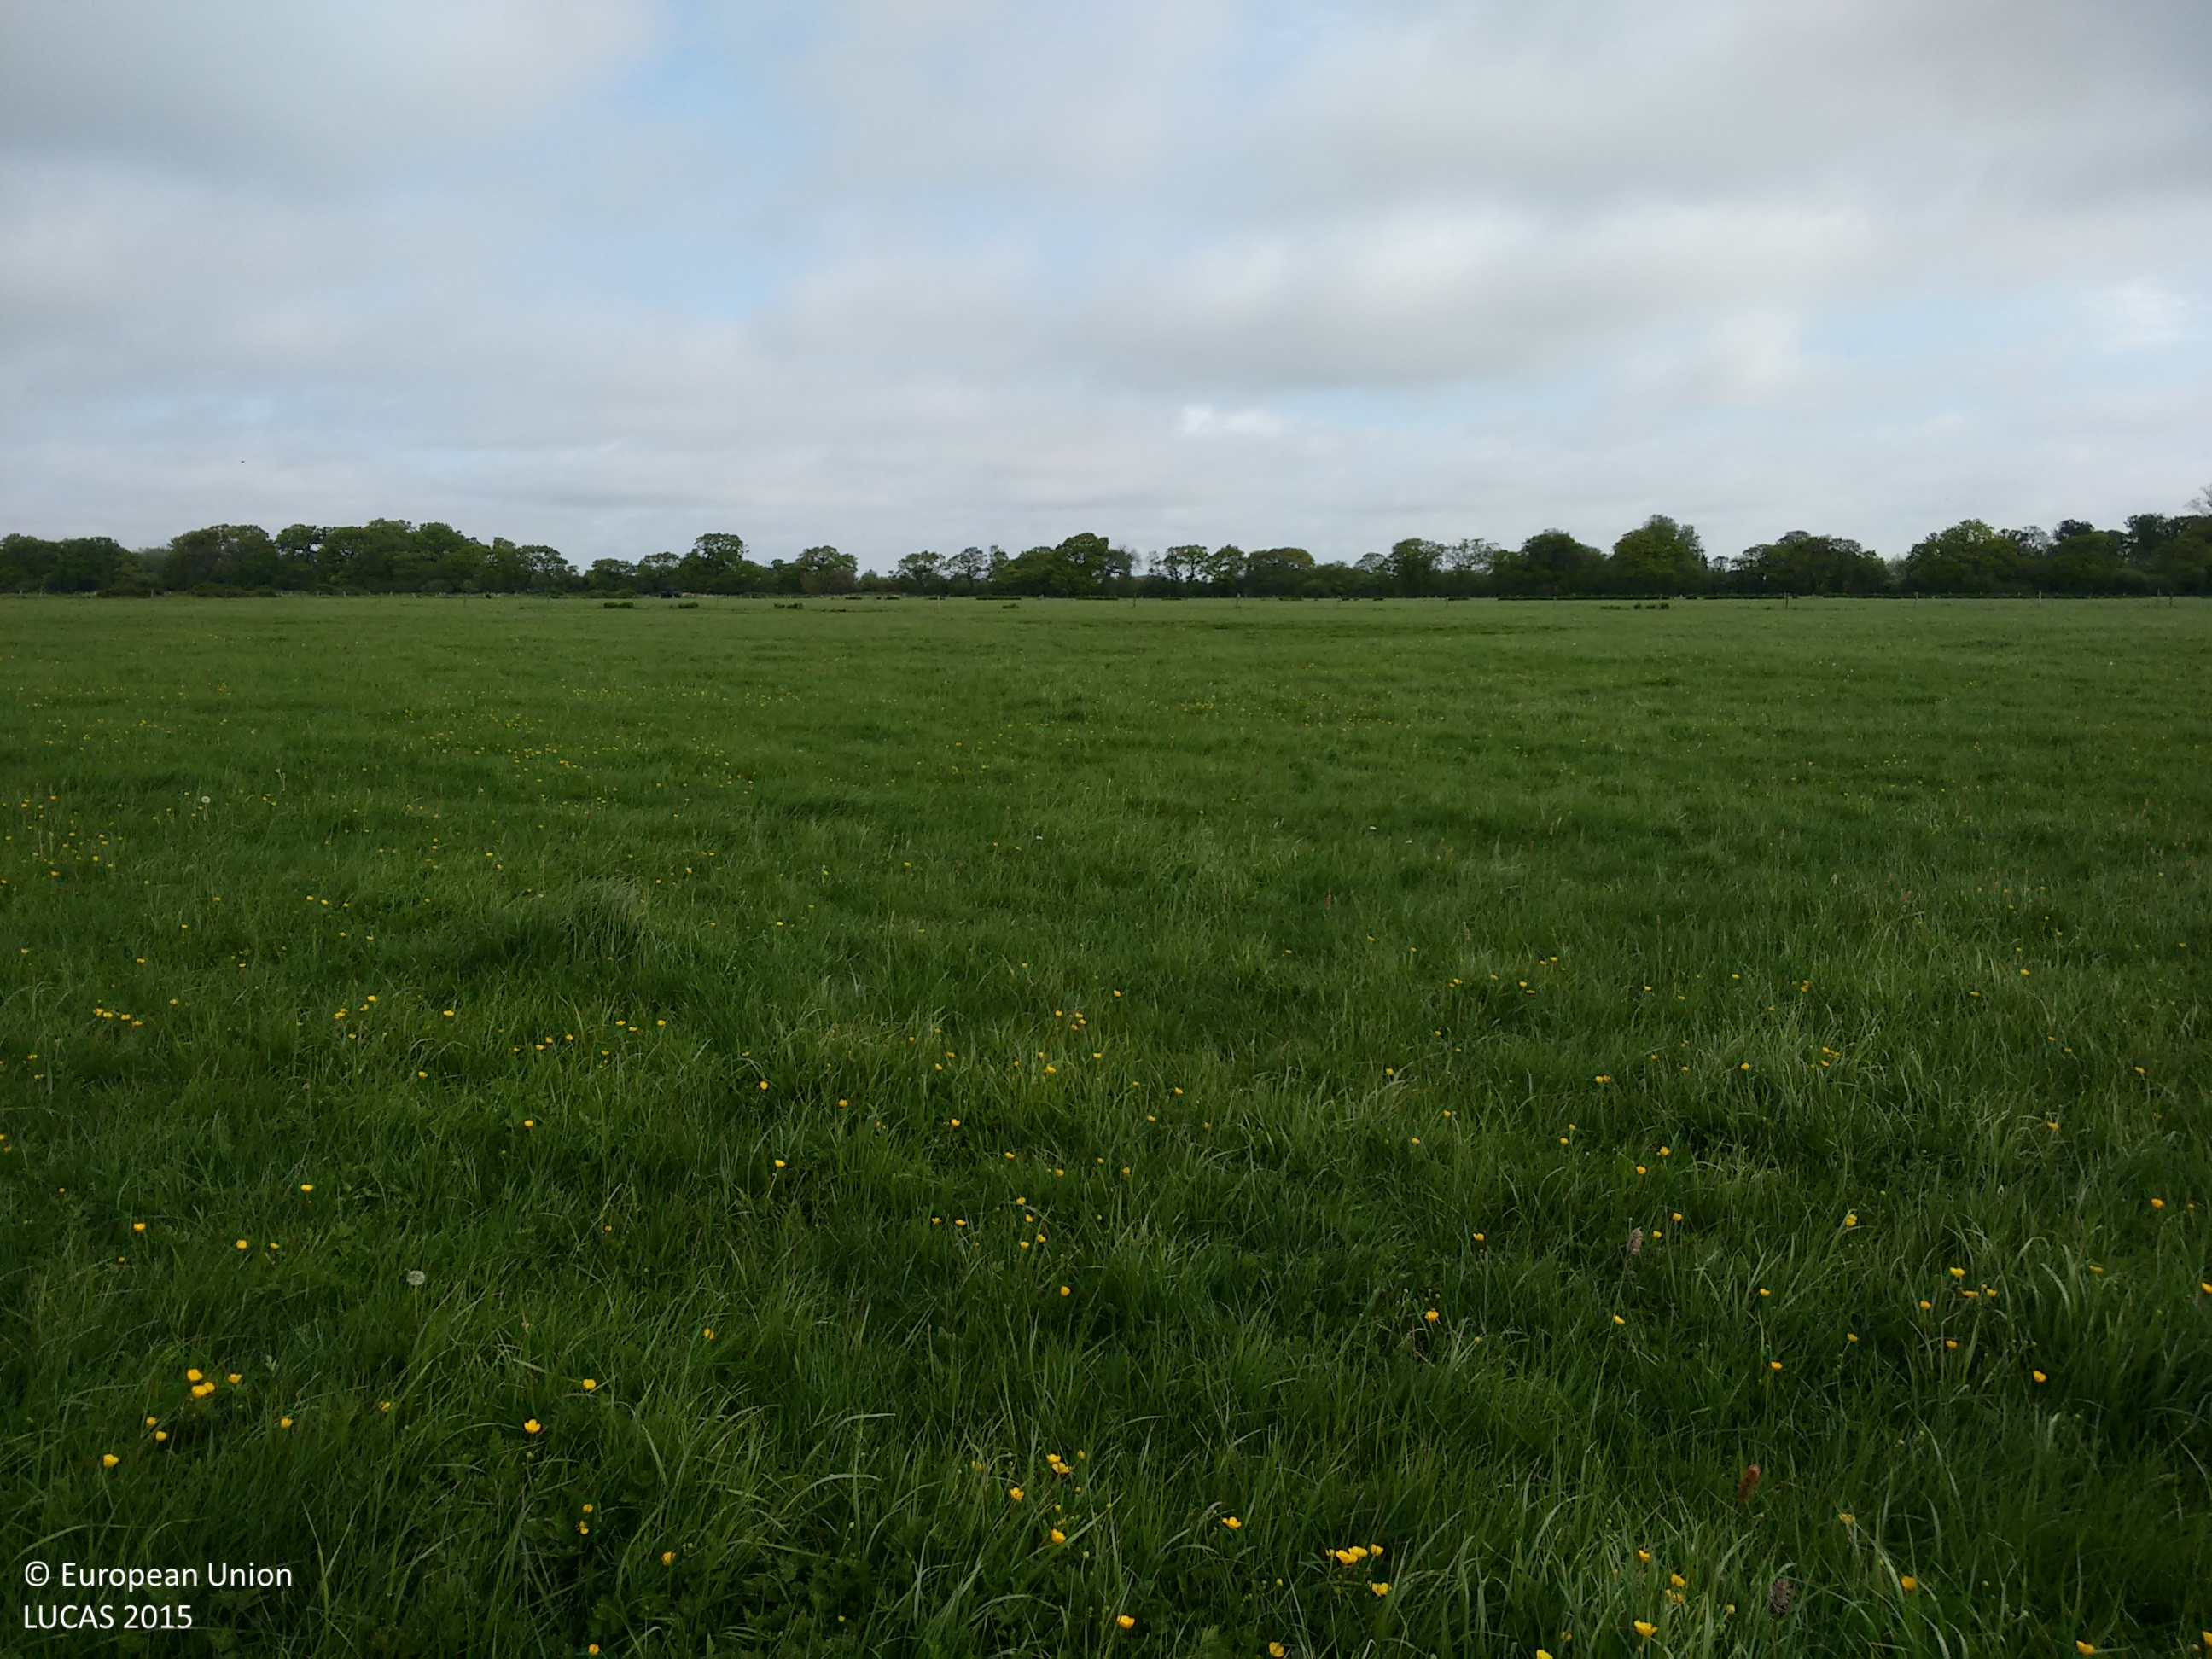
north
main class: Grassland
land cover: Grassland without tree/shrub cover
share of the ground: > 75 %
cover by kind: herbaceous plants 100 %
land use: Agriculture (excluding fallow land and kitchen gardens)
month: May
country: GB
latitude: 50.7647
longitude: -1.8376
